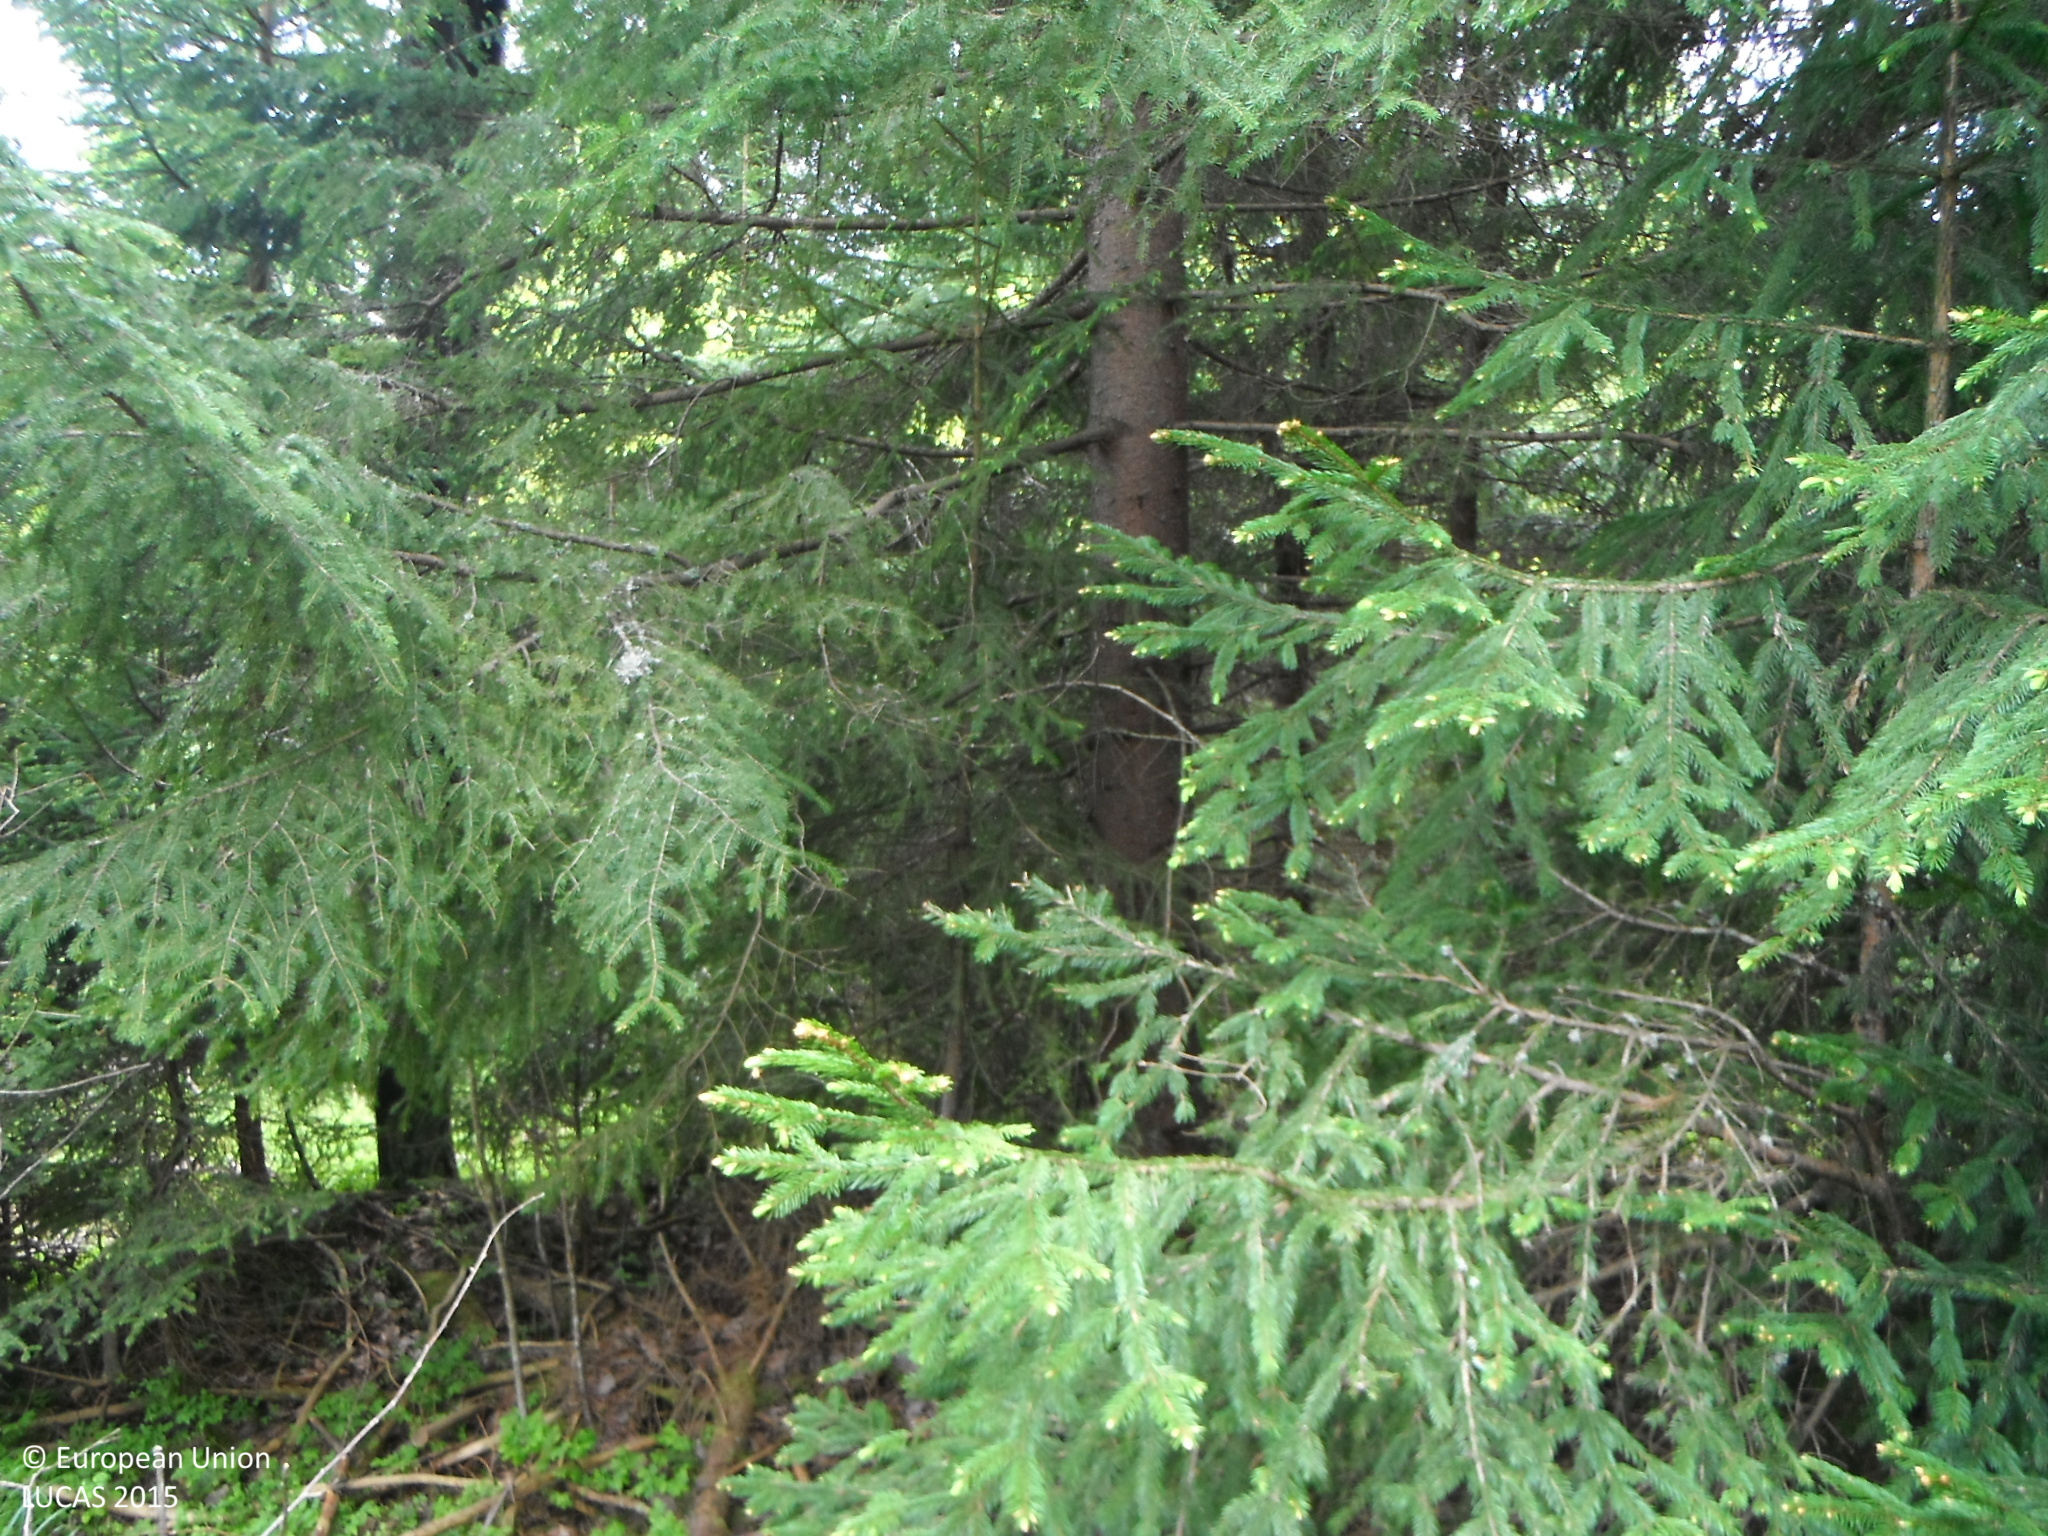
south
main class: Woodland
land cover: Spruce dominated coniferous woodland
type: alpine coniferous forest
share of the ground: > 75 %
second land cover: Spontaneously vegetated surfaces
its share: 25 - 50 %
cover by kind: coniferous forest trees 75 %, herbaceous plants 25 %
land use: Forestry
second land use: Agriculture (excluding fallow land and kitchen gardens)
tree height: > 5 m
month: June
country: SK
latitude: 49.1116
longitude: 19.7690
